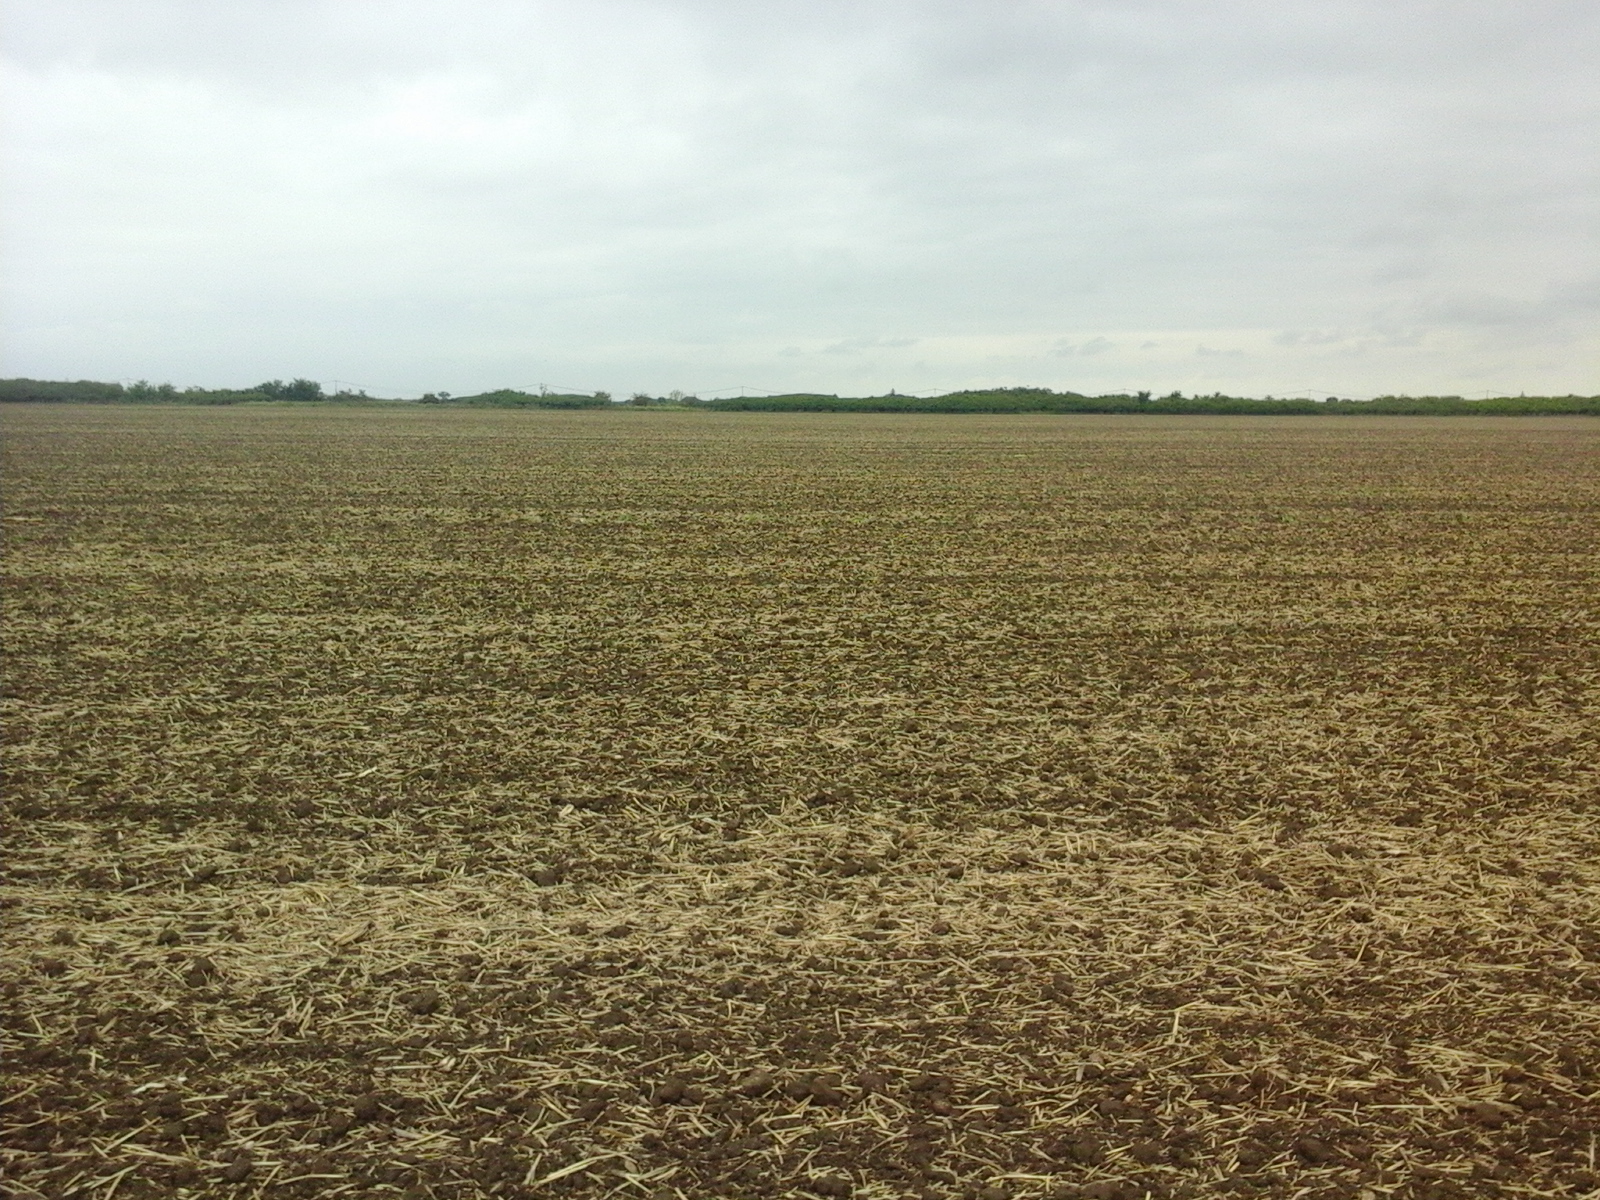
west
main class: Cropland
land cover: Common wheat
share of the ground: < 10 %
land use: Agriculture (excluding fallow land and kitchen gardens)
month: September
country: RO
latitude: 47.1901
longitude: 21.9385
